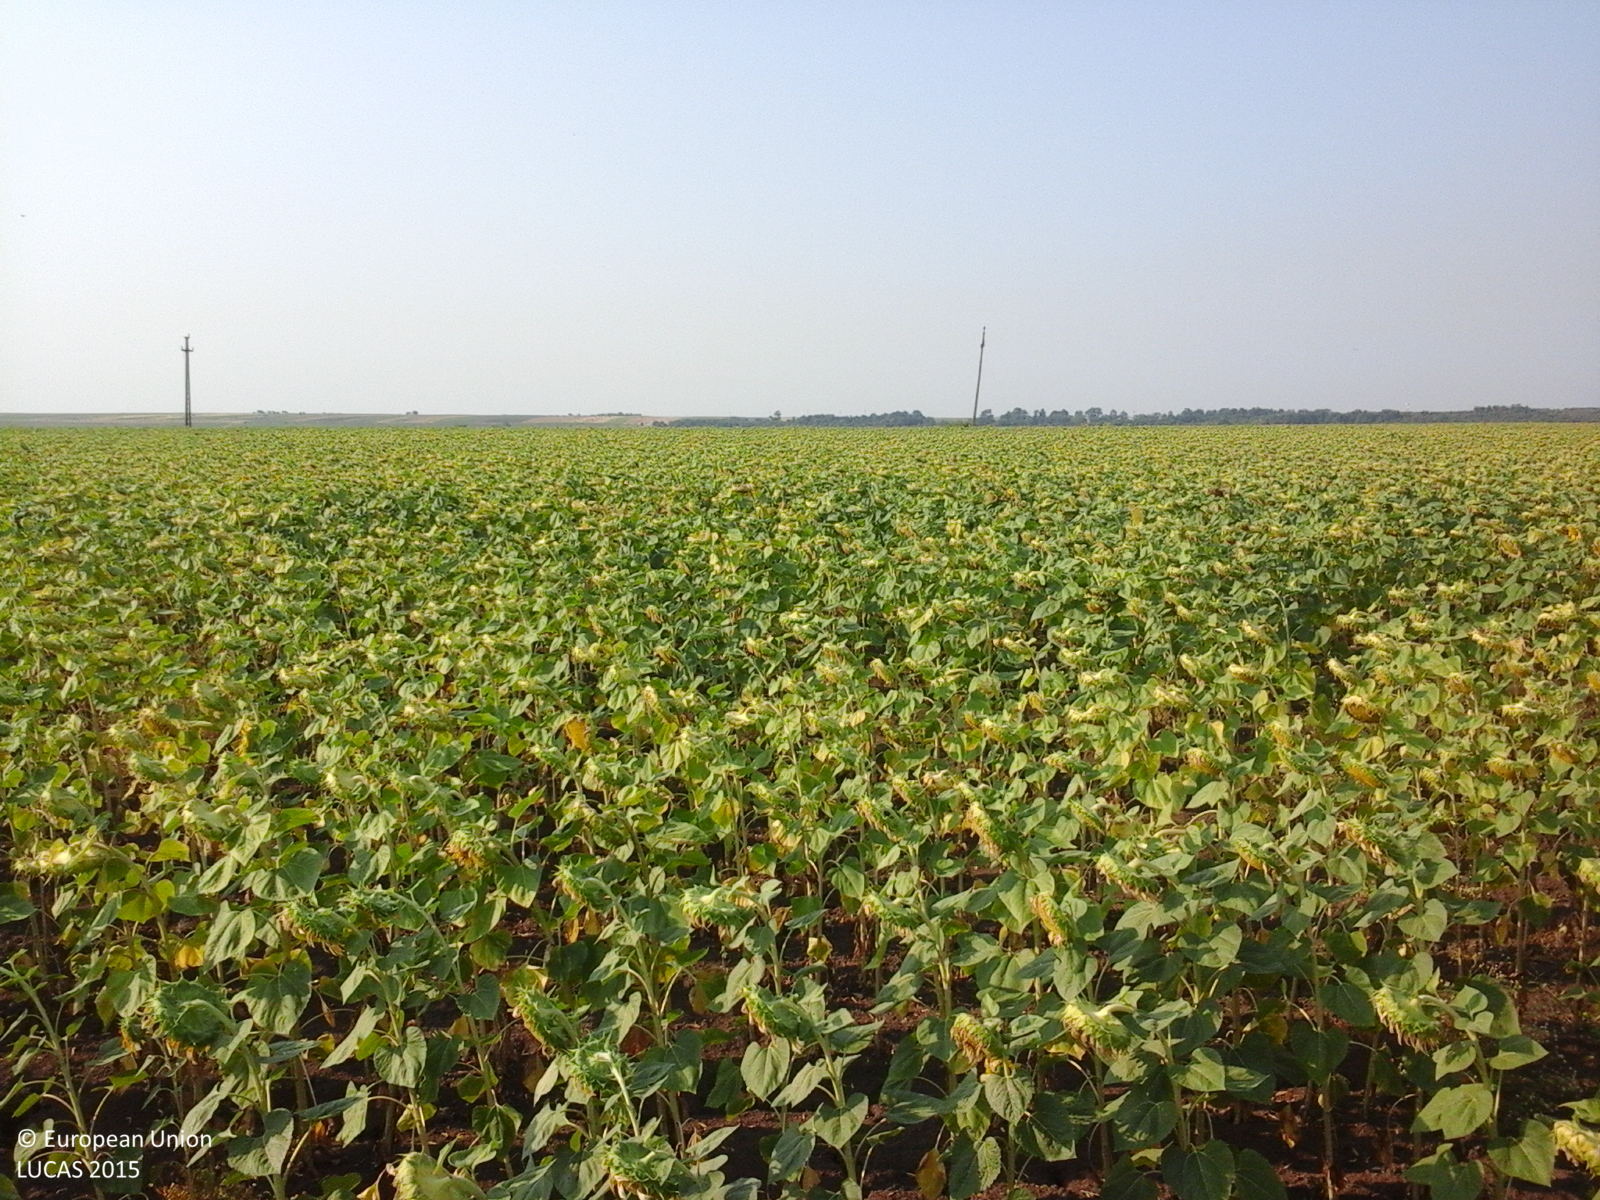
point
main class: Cropland
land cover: Sunflower
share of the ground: > 75 %
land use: Agriculture (excluding fallow land and kitchen gardens)
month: August
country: RO
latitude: 44.4244
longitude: 23.2756
